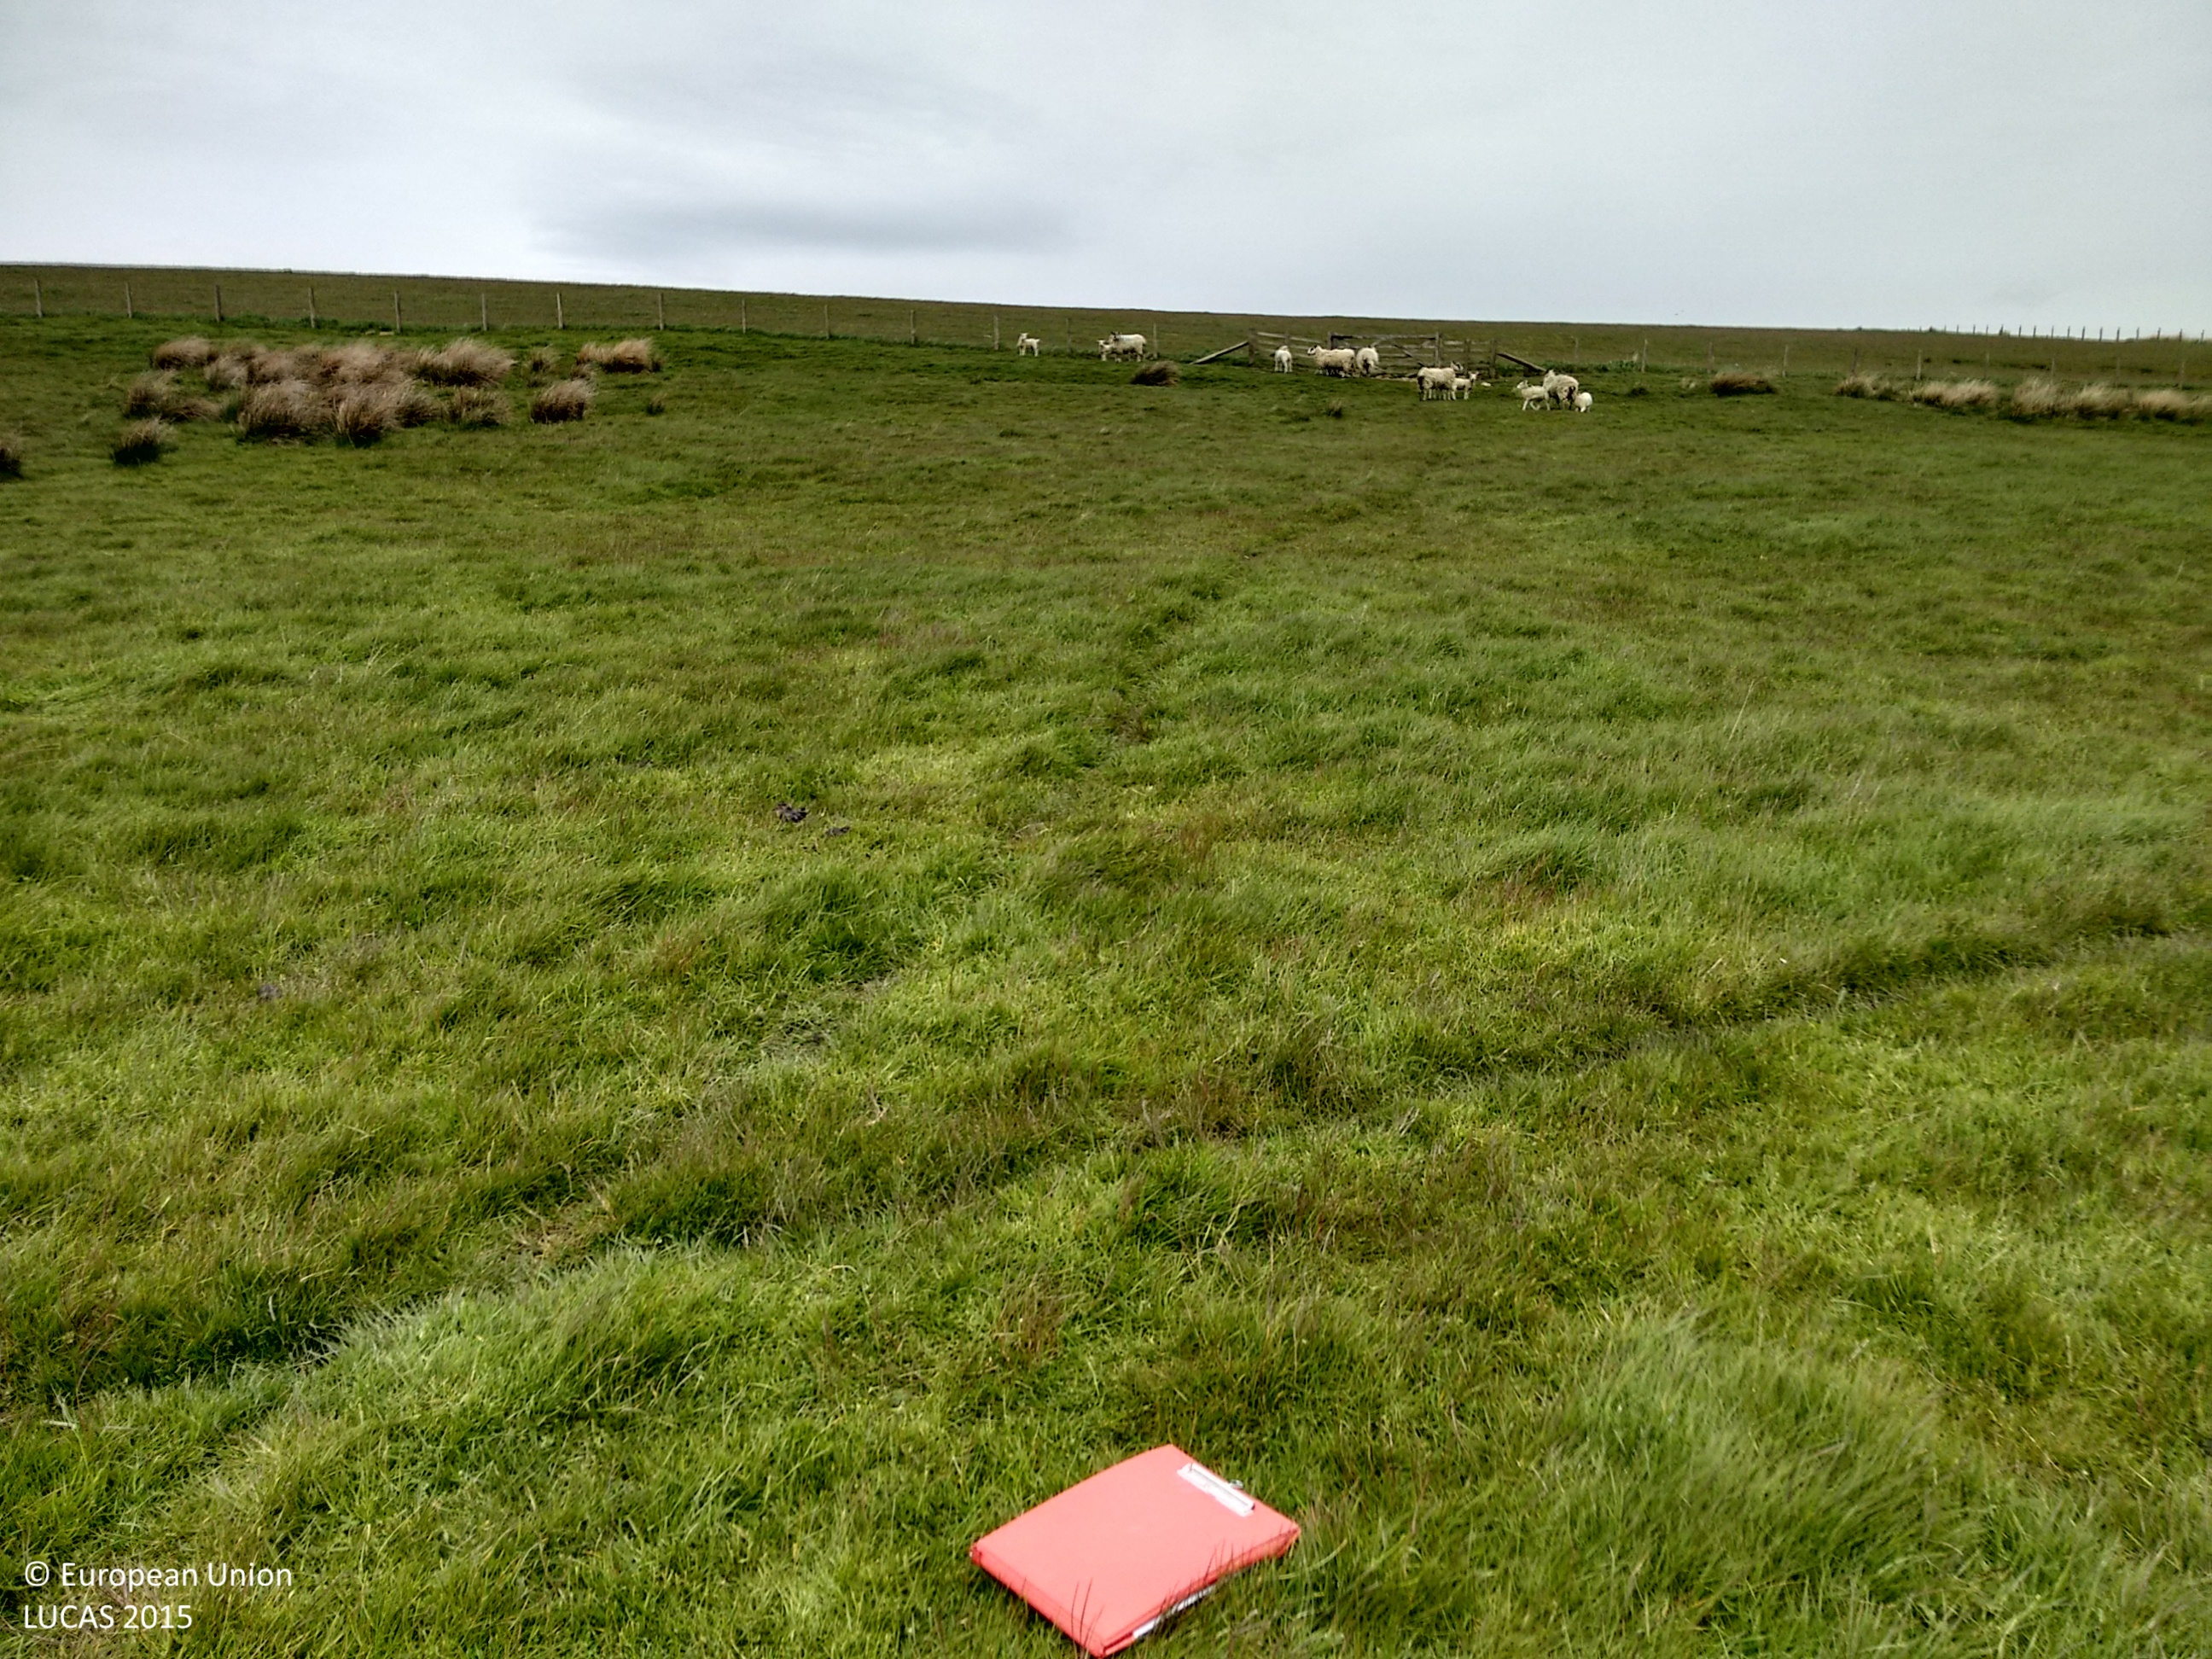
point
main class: Grassland
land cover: Grassland without tree/shrub cover
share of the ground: > 75 %
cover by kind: herbaceous plants 100 %
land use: Agriculture (excluding fallow land and kitchen gardens)
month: May
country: GB
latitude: 54.9073
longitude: -2.2398
